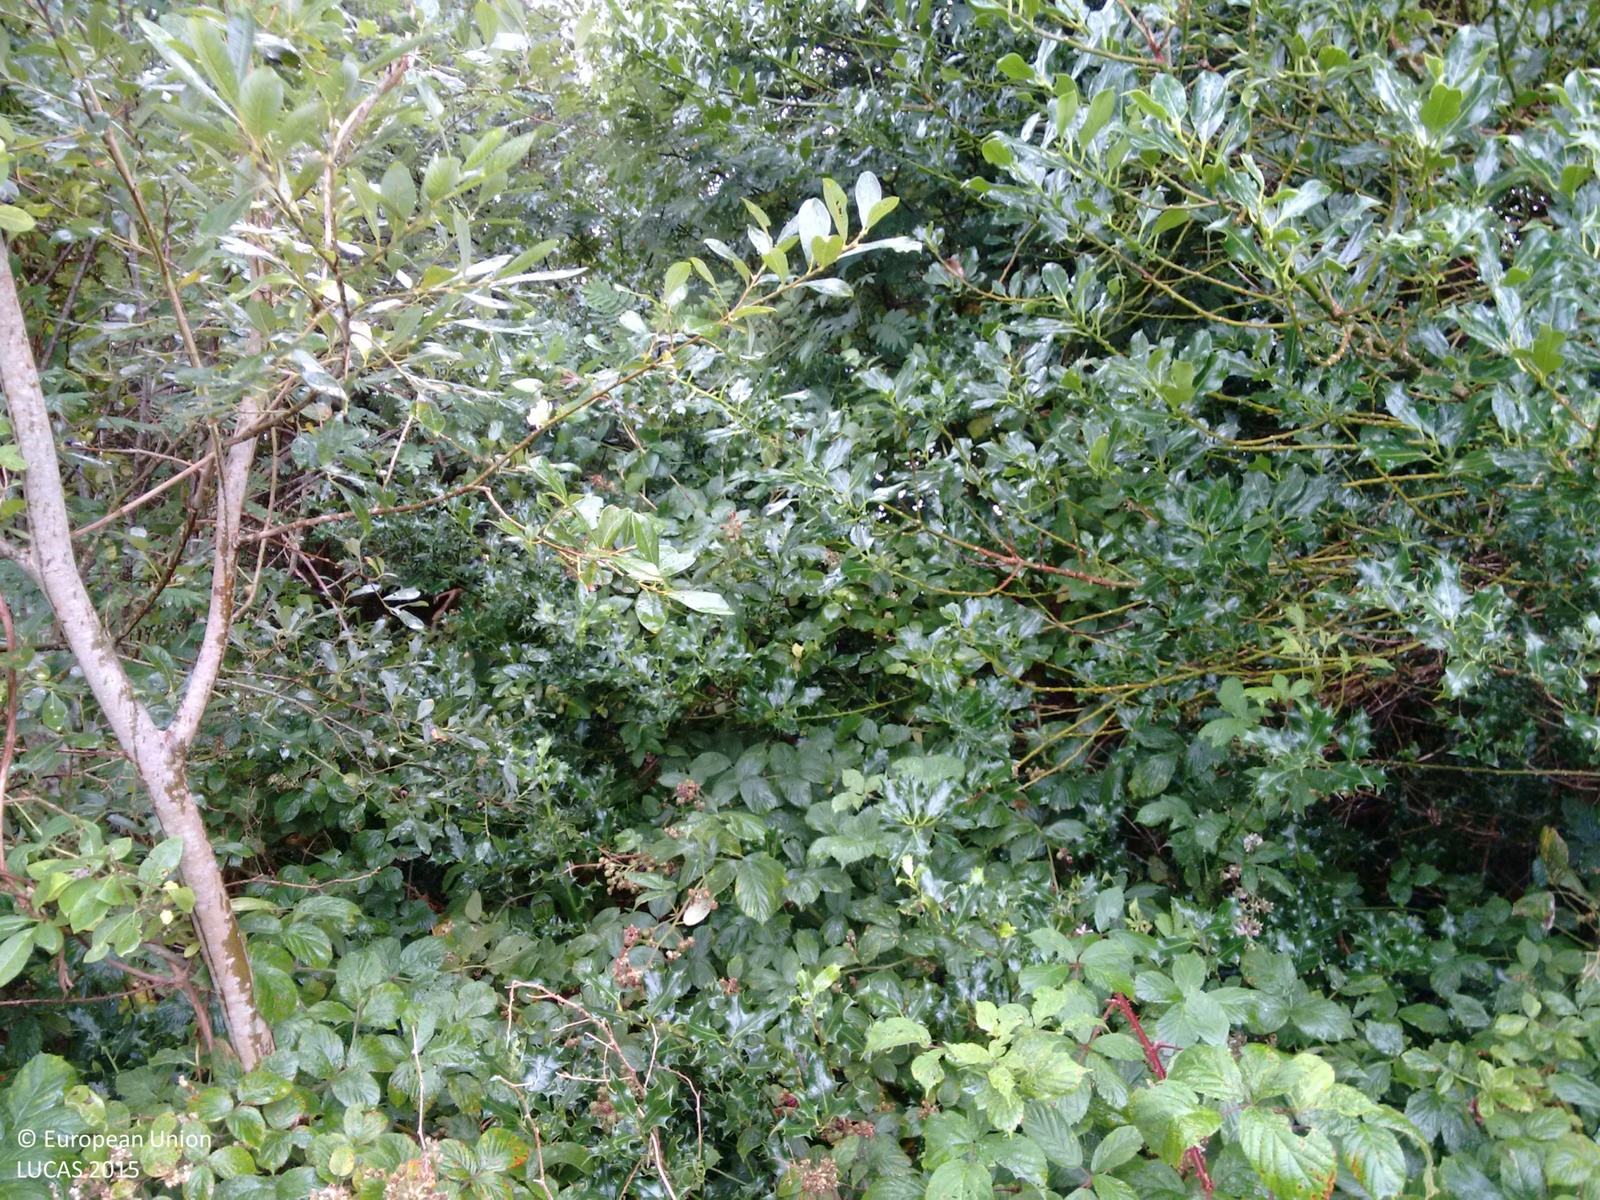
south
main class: Woodland
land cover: Broadleaved woodland
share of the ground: > 75 %
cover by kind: broadleaved forest trees 80 %, herbaceous plants 20 %
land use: Semi-natural and natural areas not in use
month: September
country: IE
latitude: 53.9939
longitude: -9.3058
